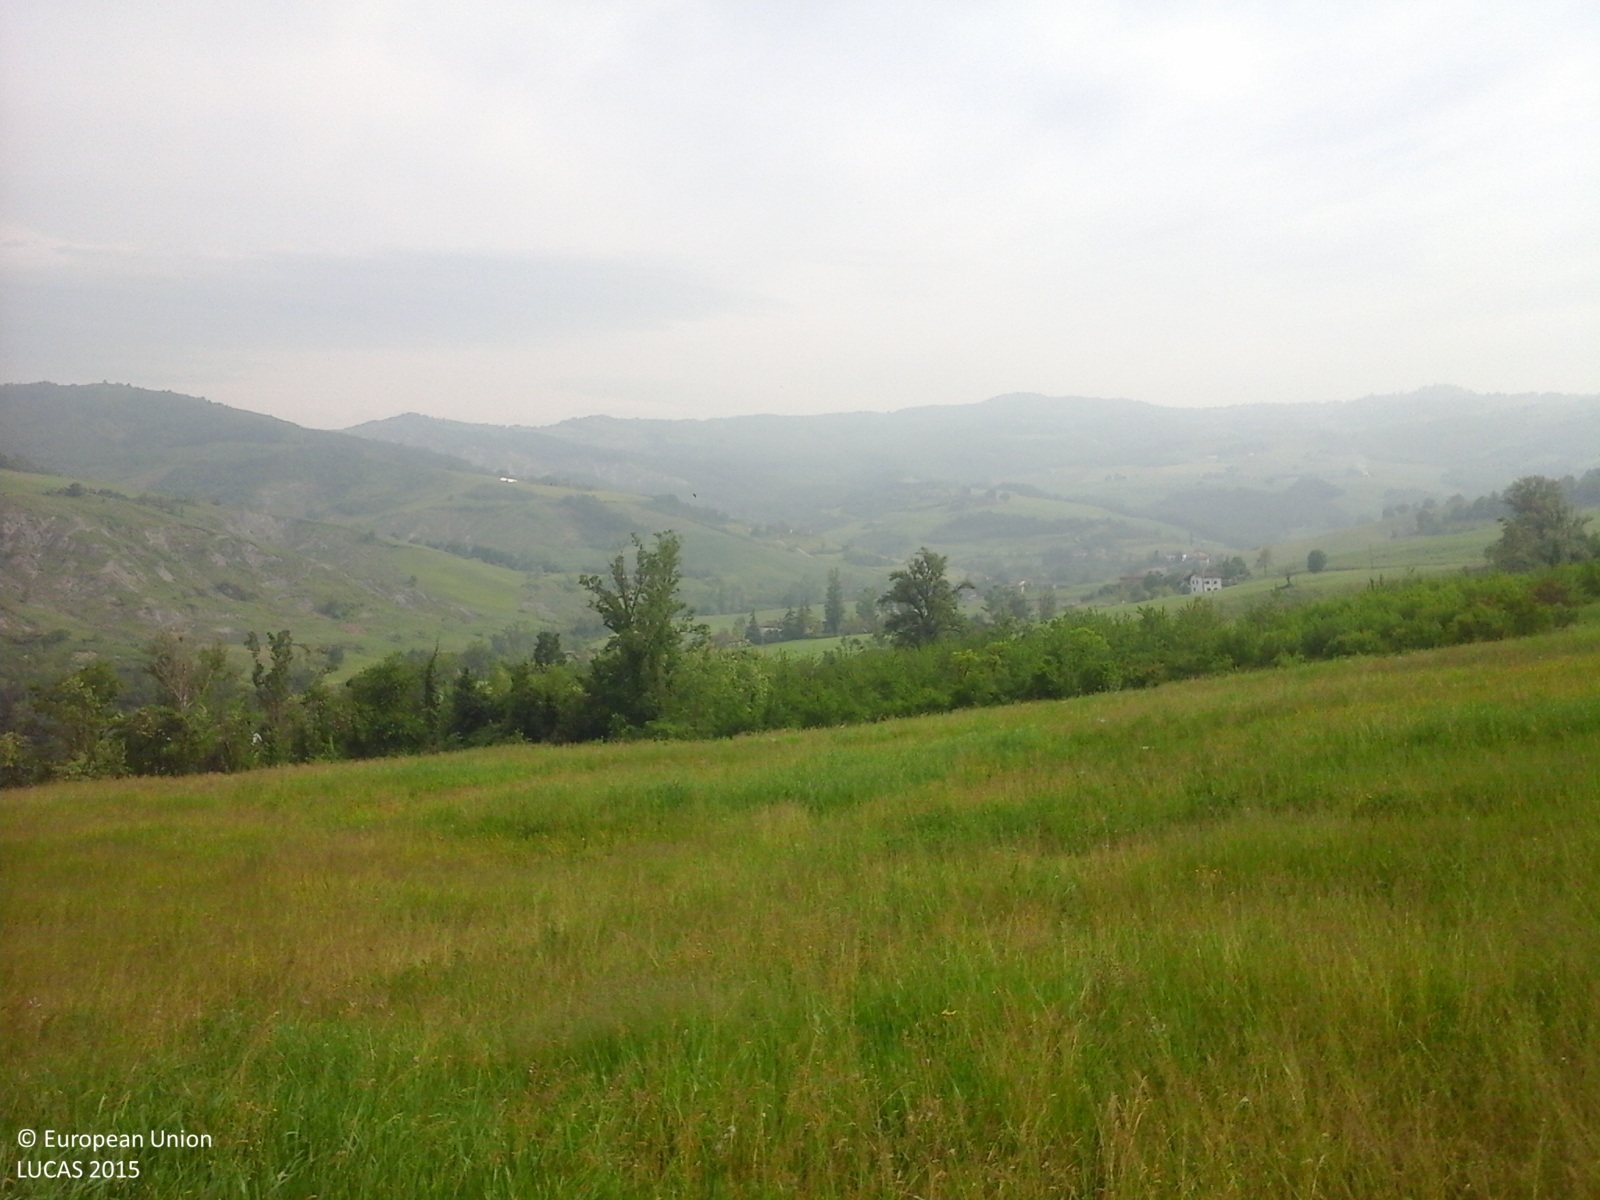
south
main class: Cropland
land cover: Lucerne
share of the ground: > 75 %
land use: Agriculture (excluding fallow land and kitchen gardens)
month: May
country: IT
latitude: 44.4175
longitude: 11.0401
